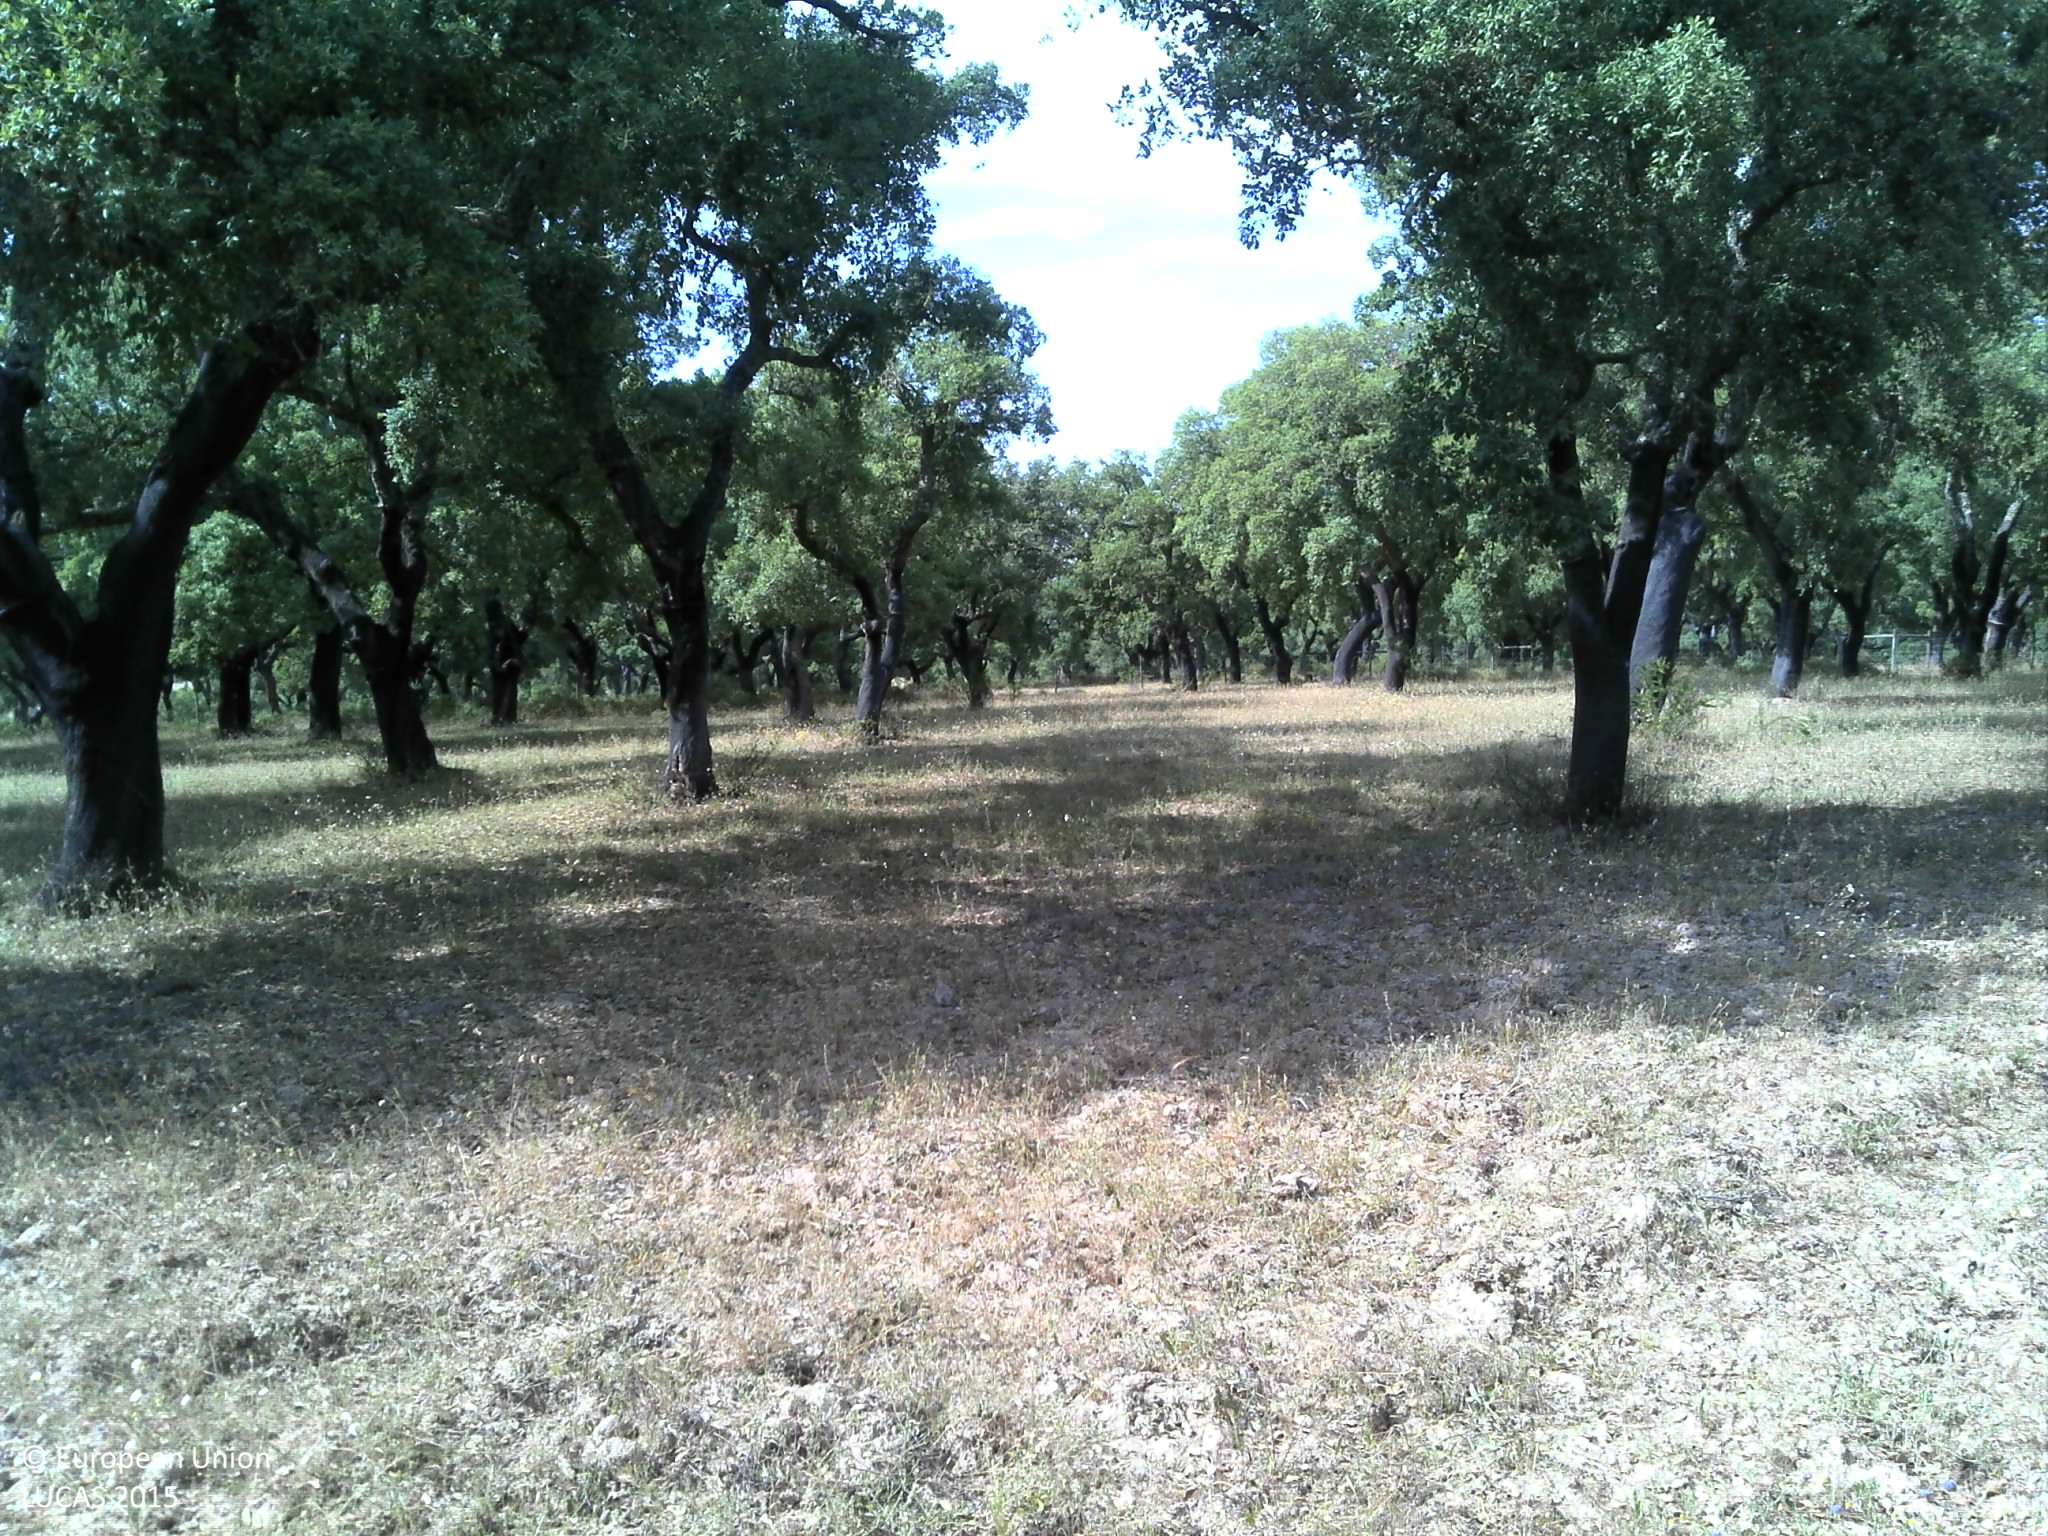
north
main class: Woodland
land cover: Broadleaved woodland
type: broadleaved evergreen forest
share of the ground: 50 - 75 %
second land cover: Grassland without tree/shrub cover
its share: 10 - 25 %
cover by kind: broadleaved forest trees 60 %, herbaceous plants 20 %, unconsolidated bare surface 20 %
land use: Forestry
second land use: Agriculture (excluding fallow land and kitchen gardens)
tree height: > 5 m
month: May
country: PT
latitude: 38.0694
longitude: -8.3819
